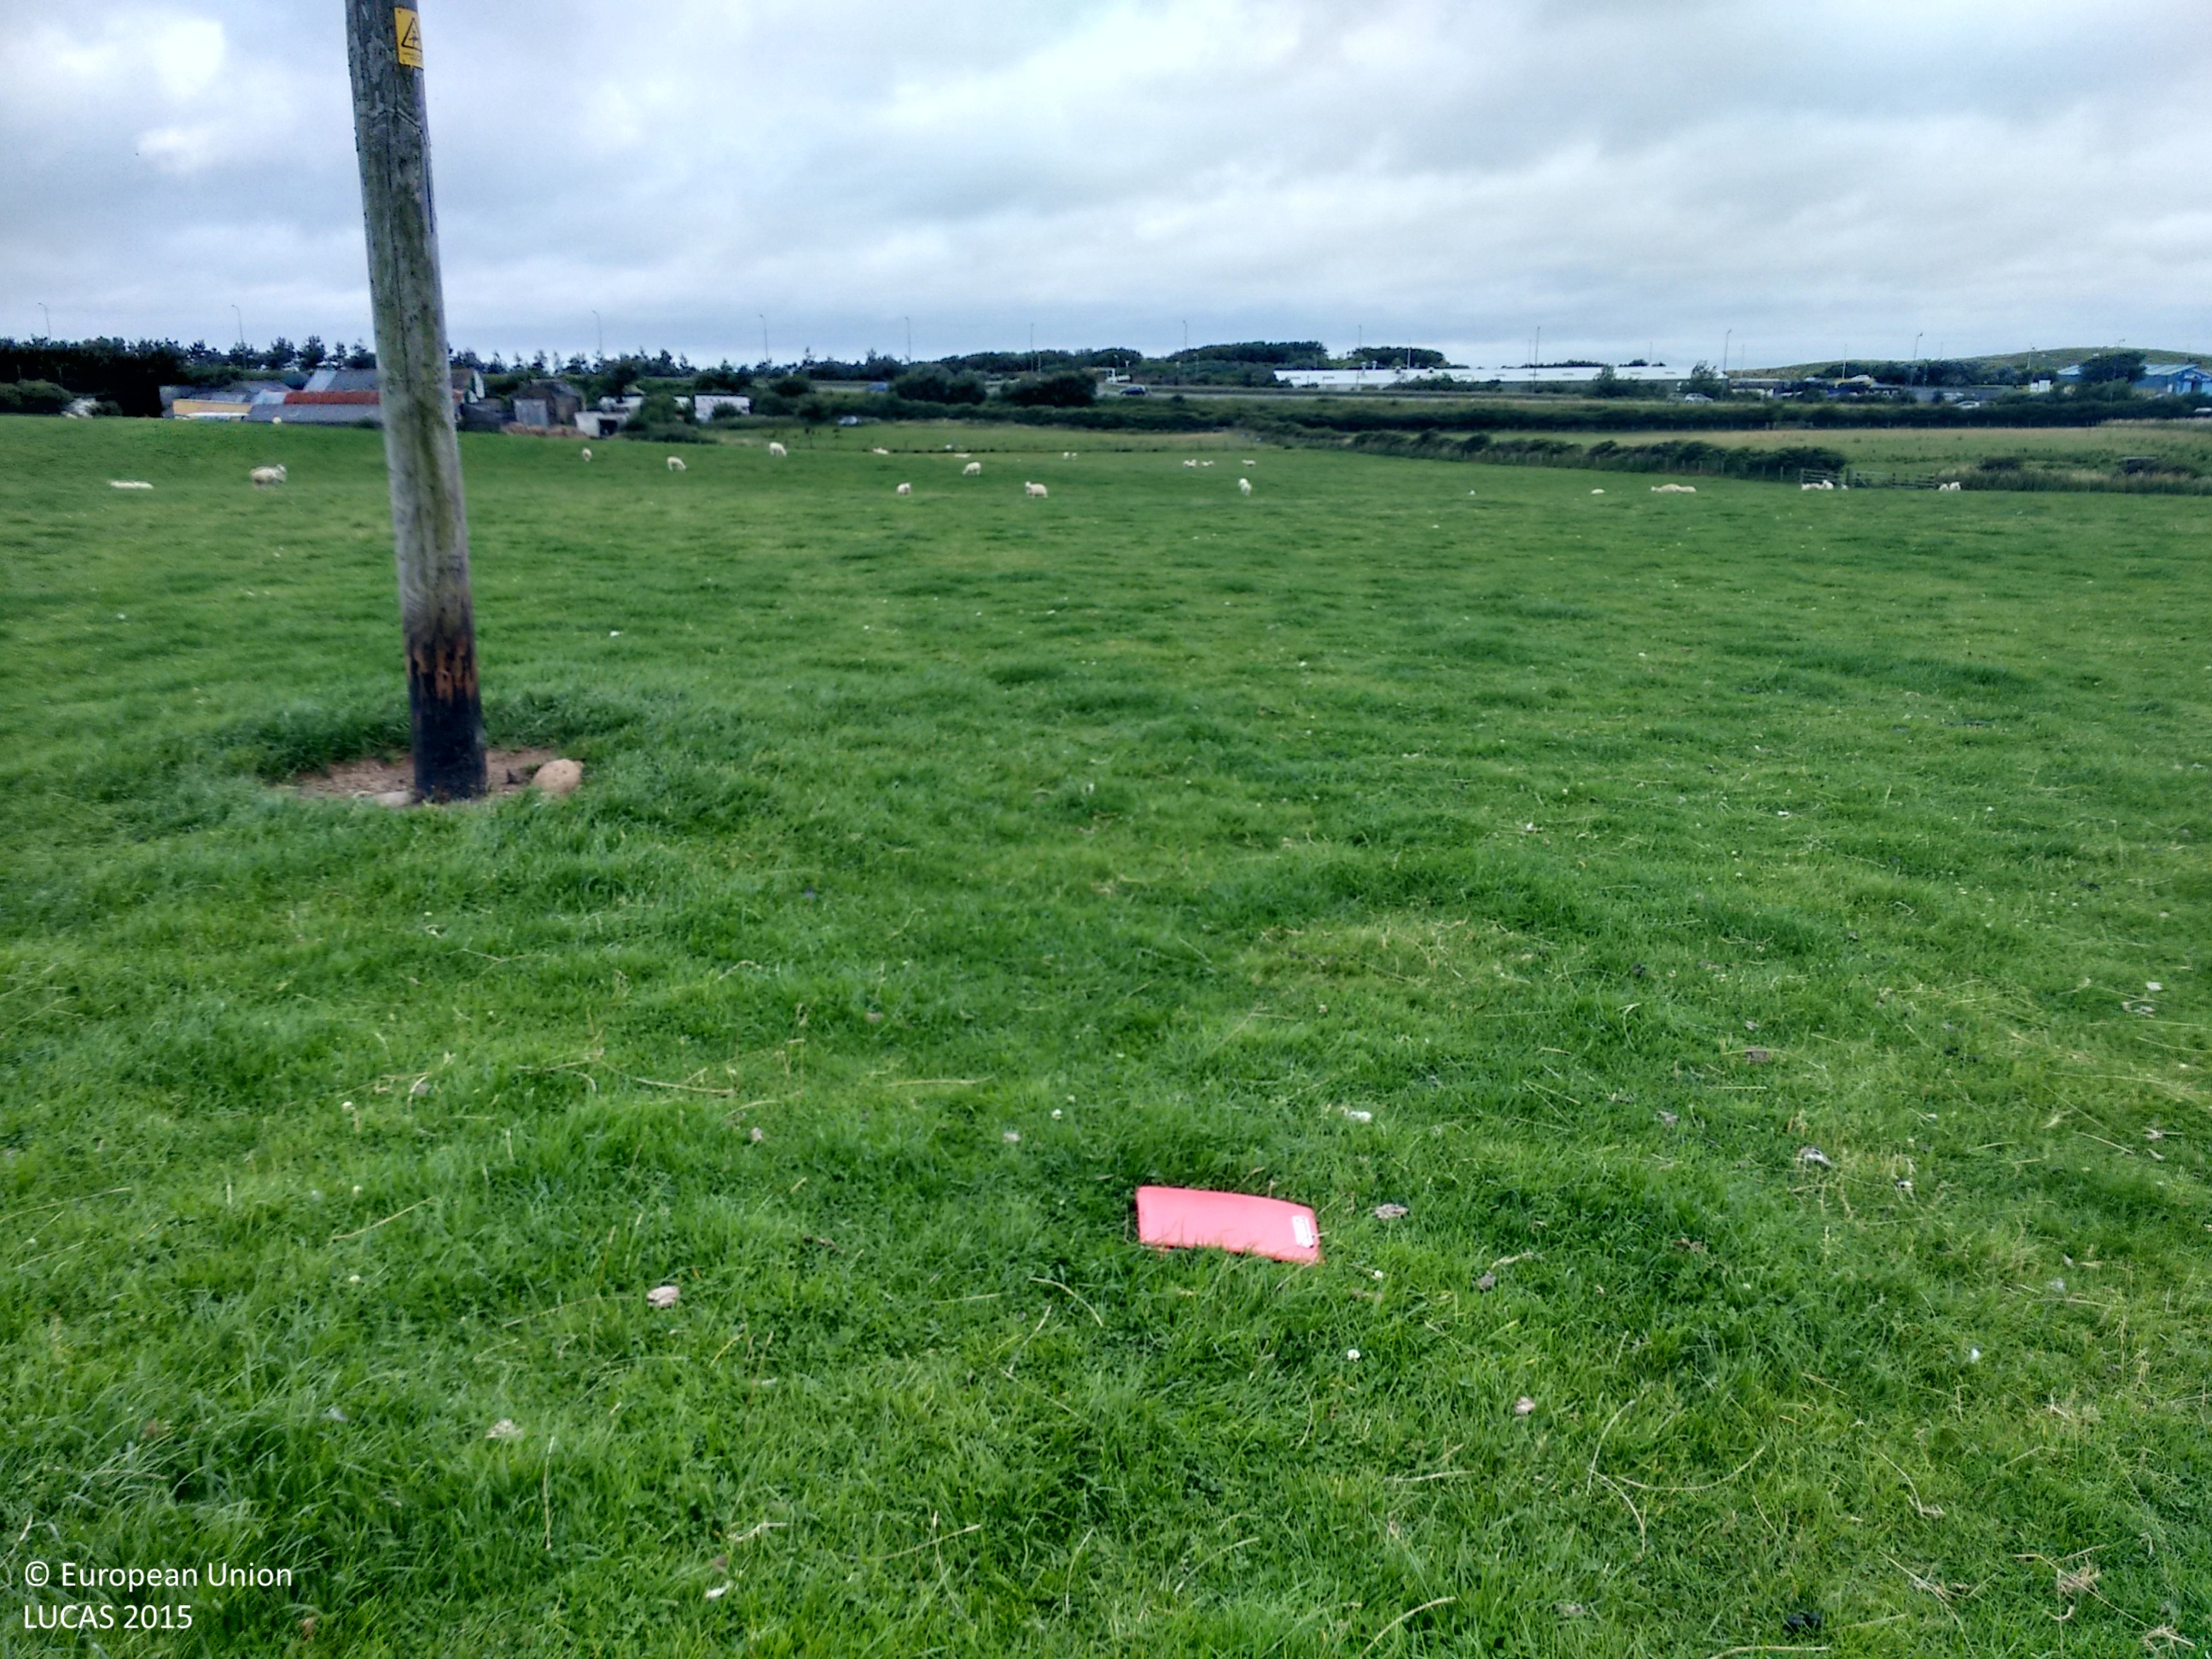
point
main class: Grassland
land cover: Grassland without tree/shrub cover
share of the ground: > 75 %
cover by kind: herbaceous plants 100 %
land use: Agriculture (excluding fallow land and kitchen gardens)
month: August
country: GB
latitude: 54.7027
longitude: -3.5049
